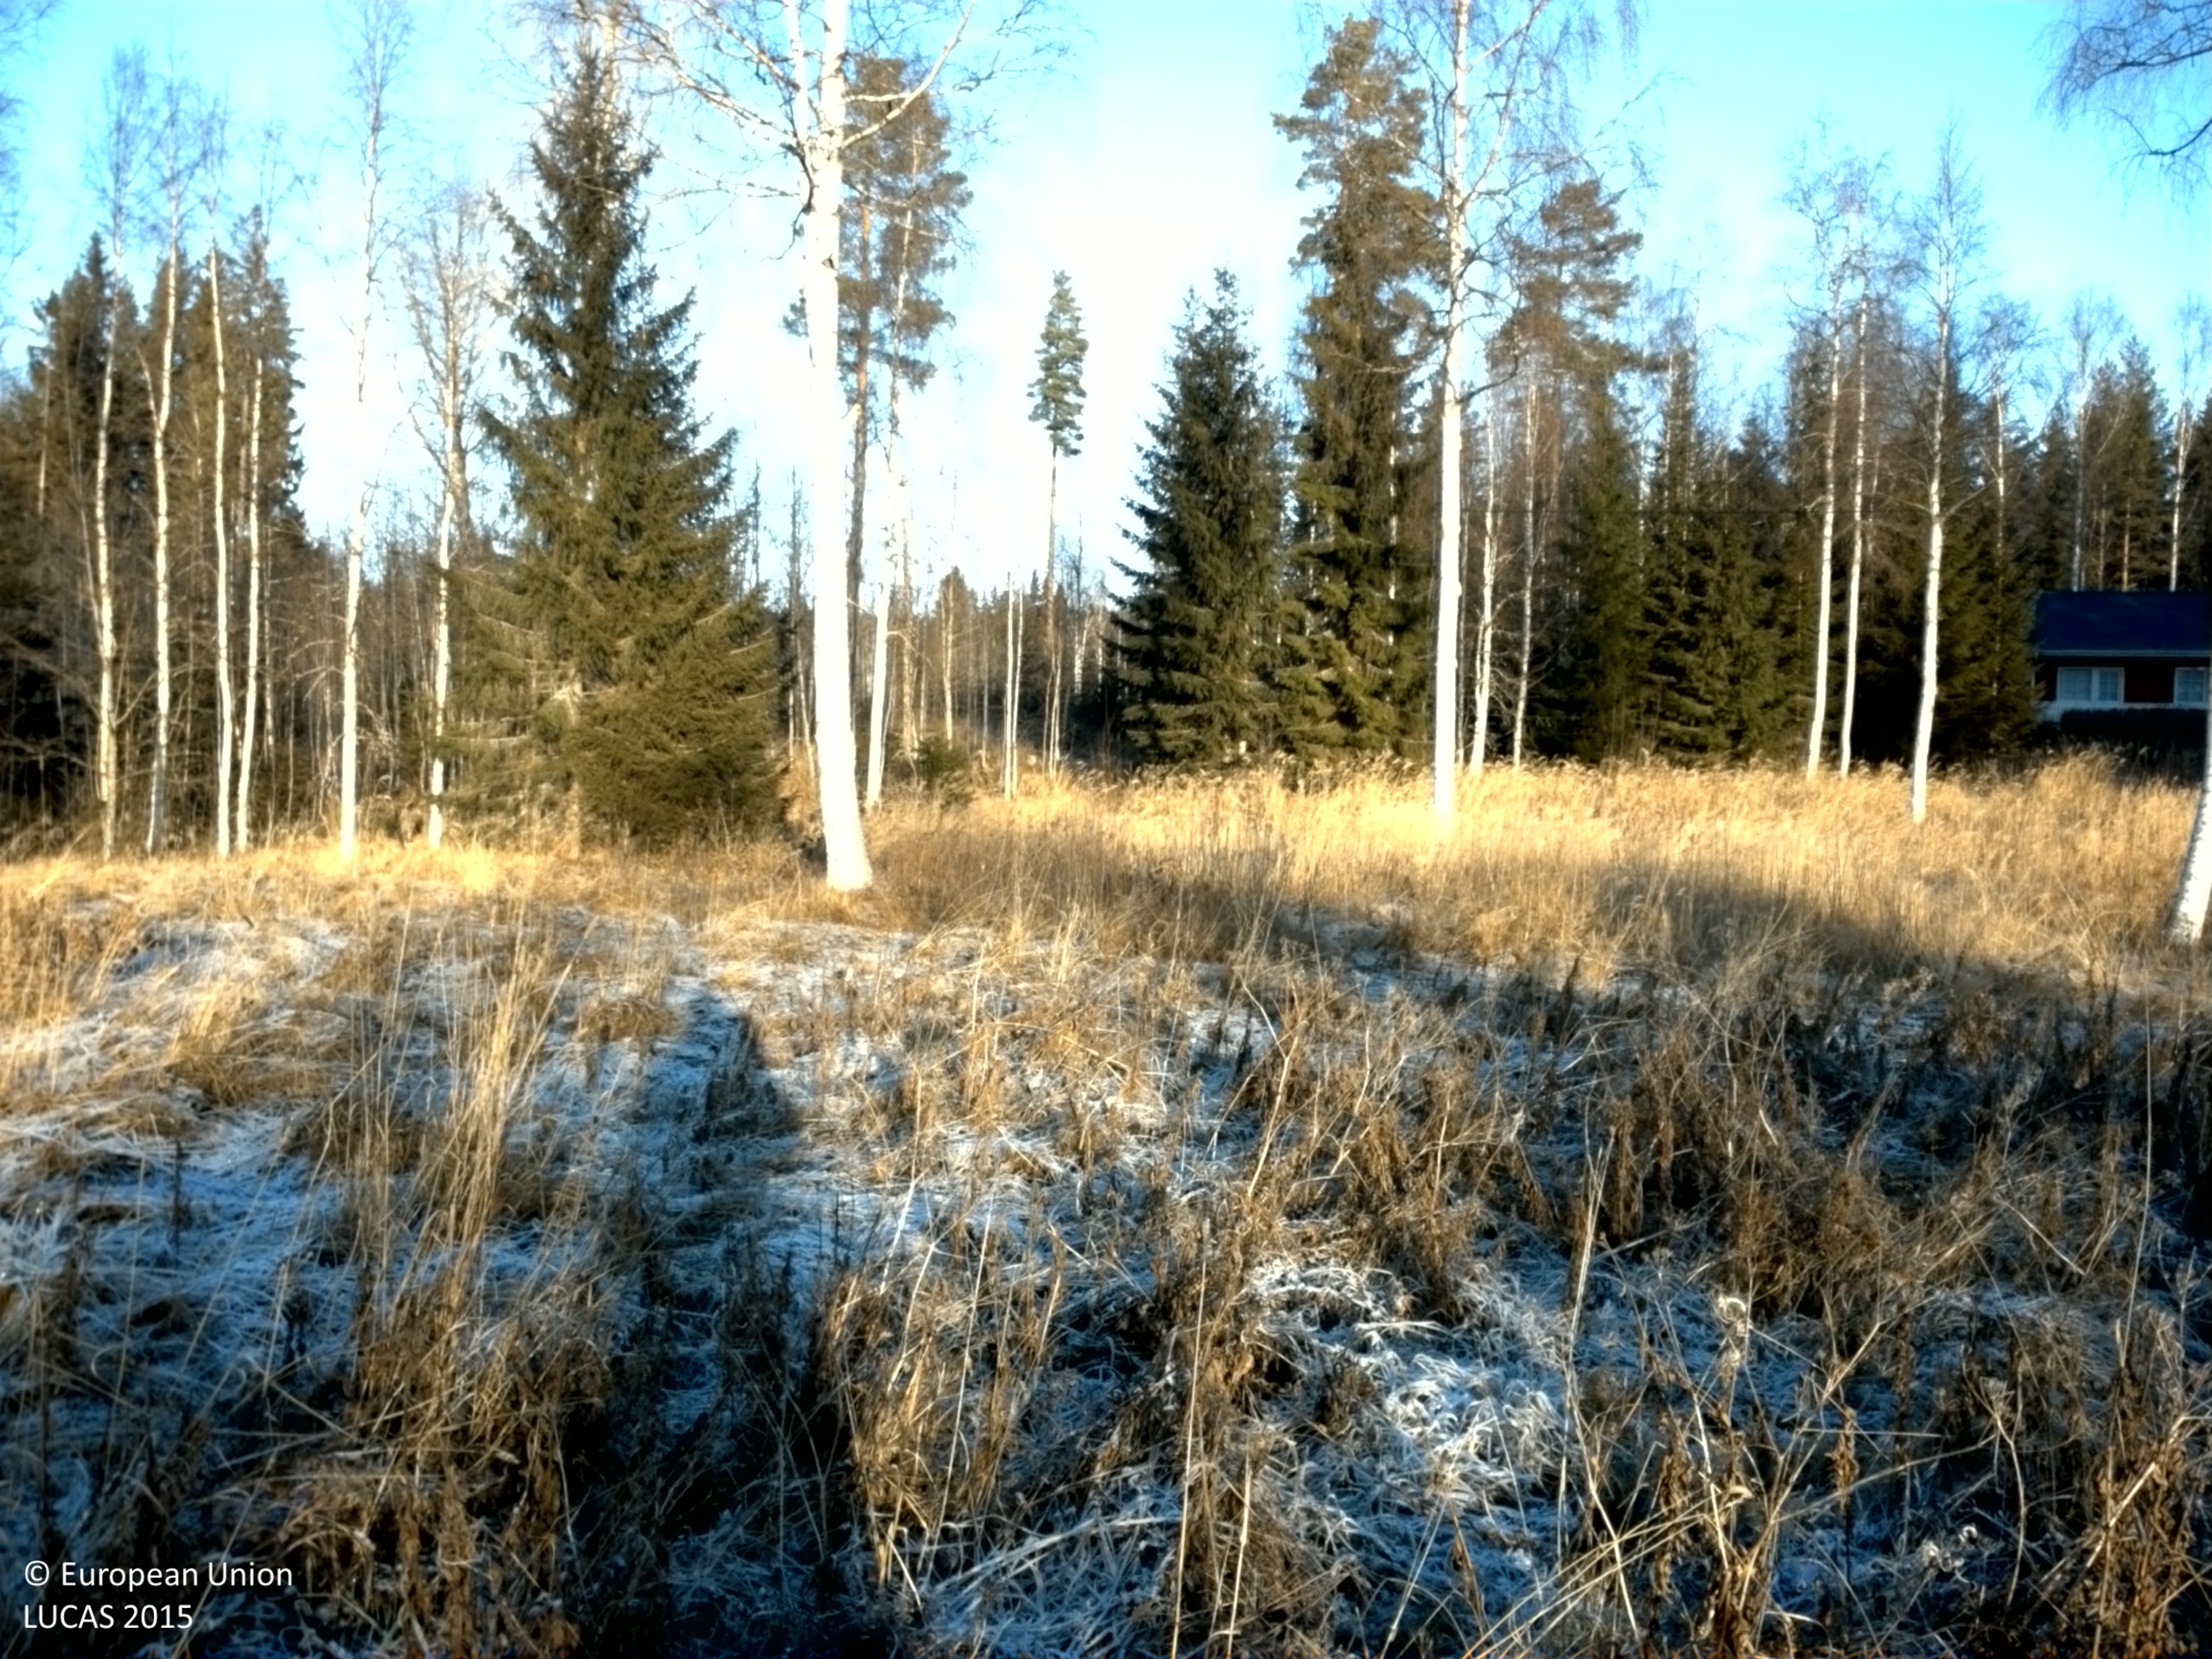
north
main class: Grassland
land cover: Grassland with sparse tree/shrub cover
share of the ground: > 75 %
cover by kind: herbaceous plants 95 %, broadleaved forest trees 5 %
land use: Amenities, museums, leisure
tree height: > 5 m
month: November
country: SE
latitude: 61.8650
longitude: 16.3125
